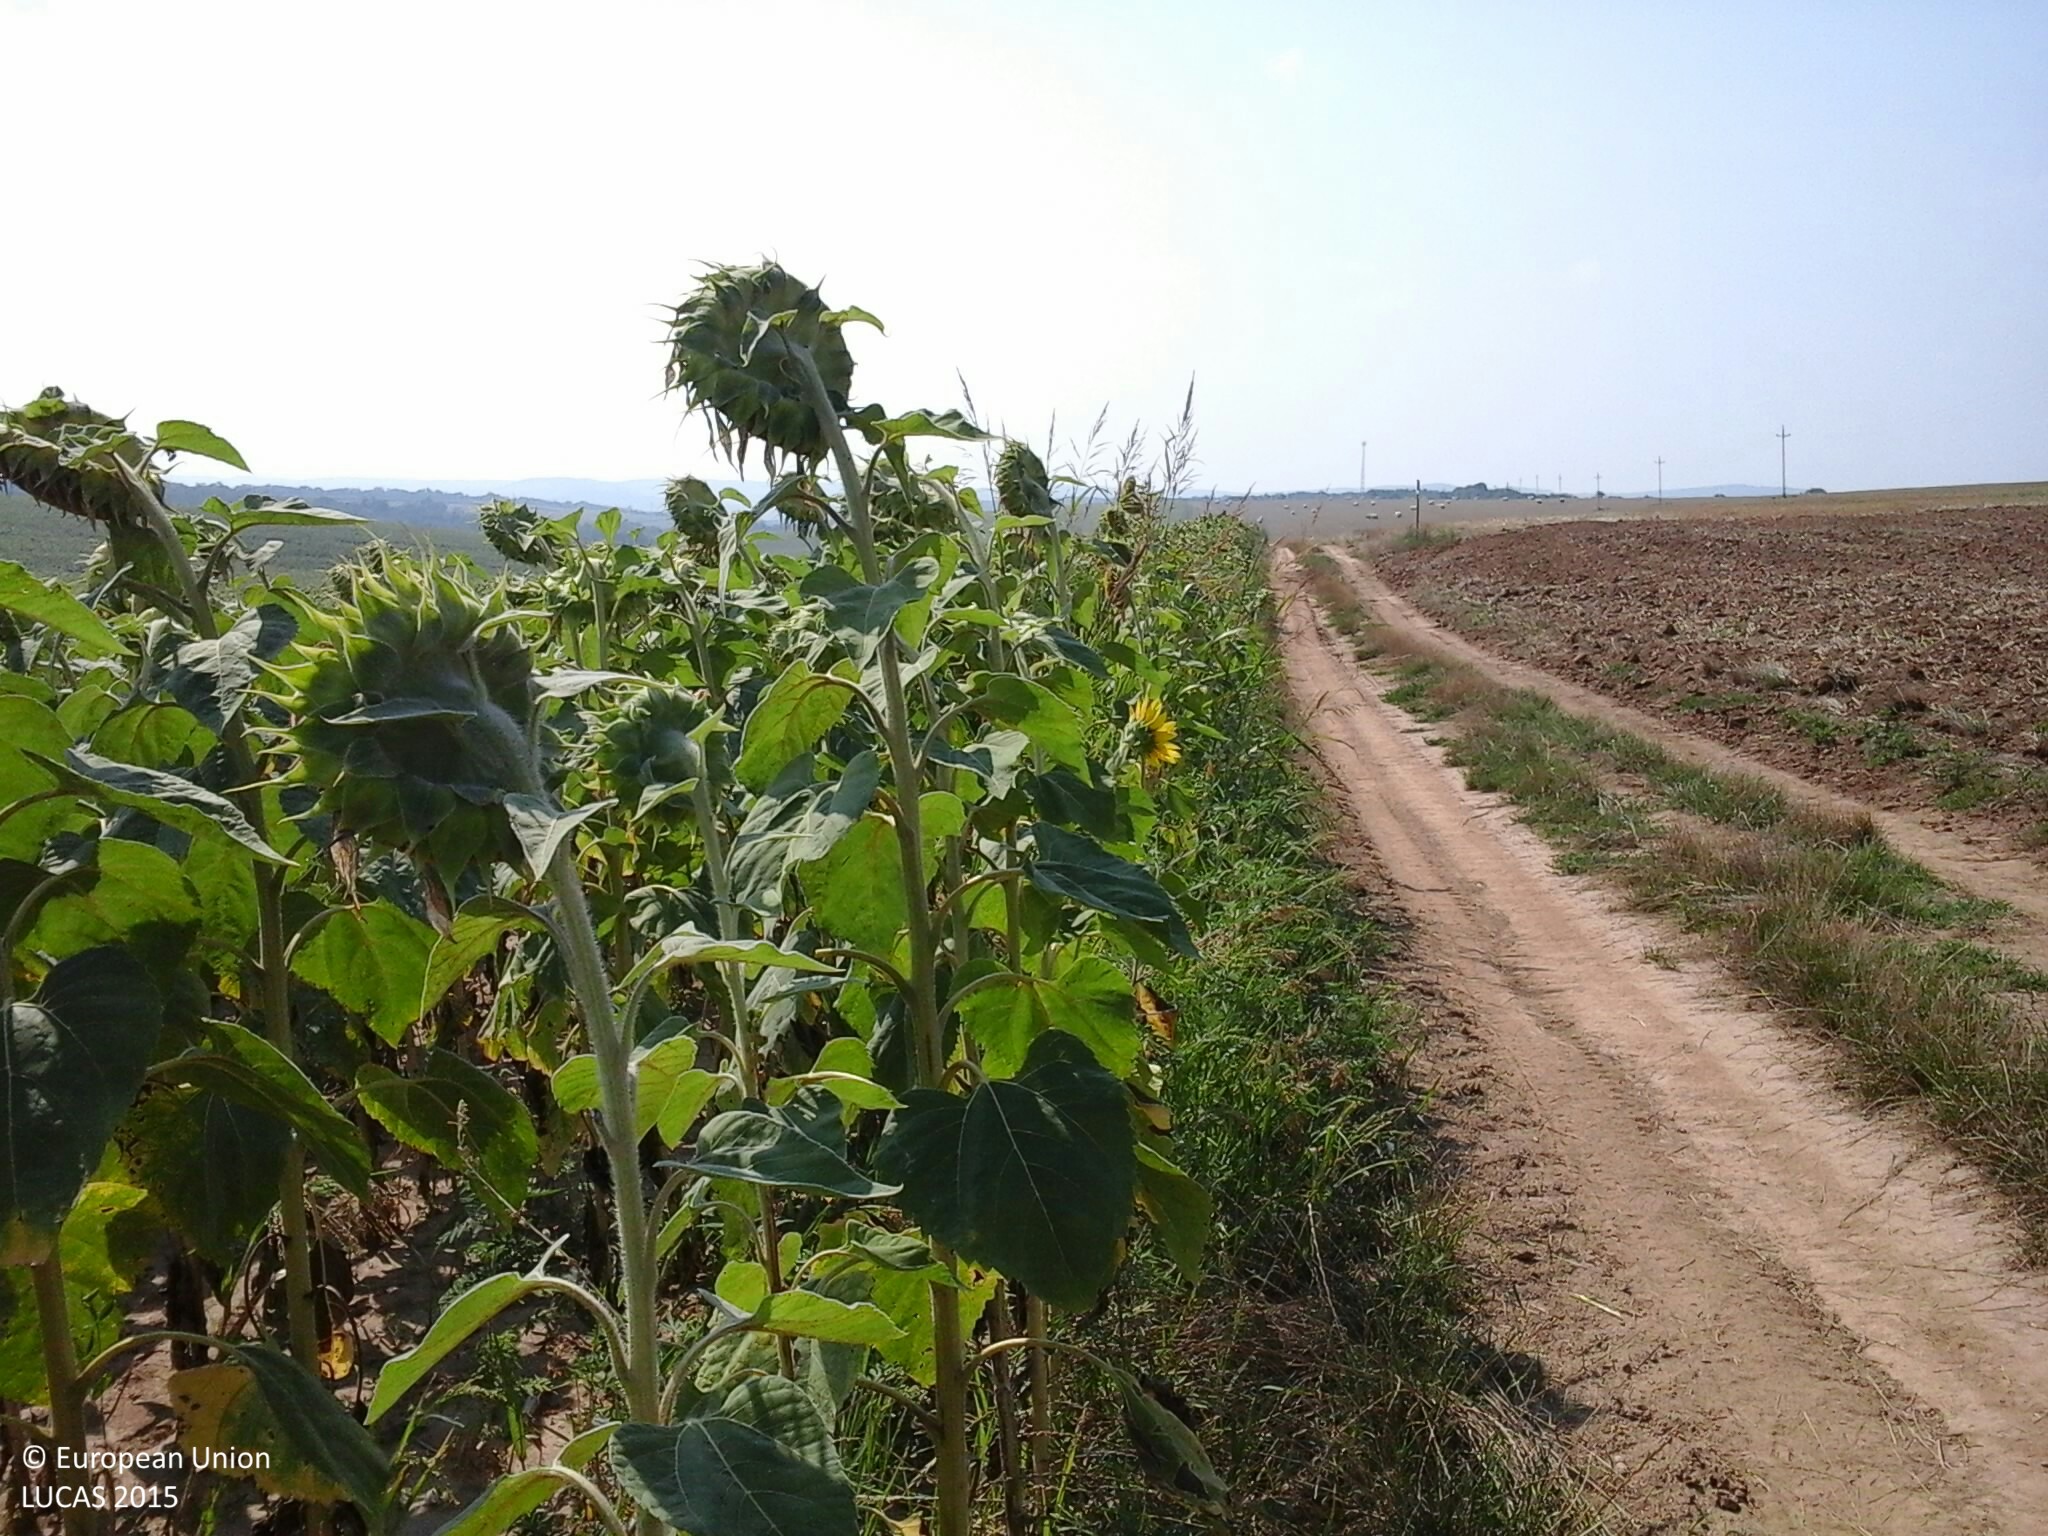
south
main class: Cropland
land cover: Sunflower
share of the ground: > 75 %
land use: Agriculture (excluding fallow land and kitchen gardens)
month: August
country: HU
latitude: 46.6529
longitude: 17.9392
